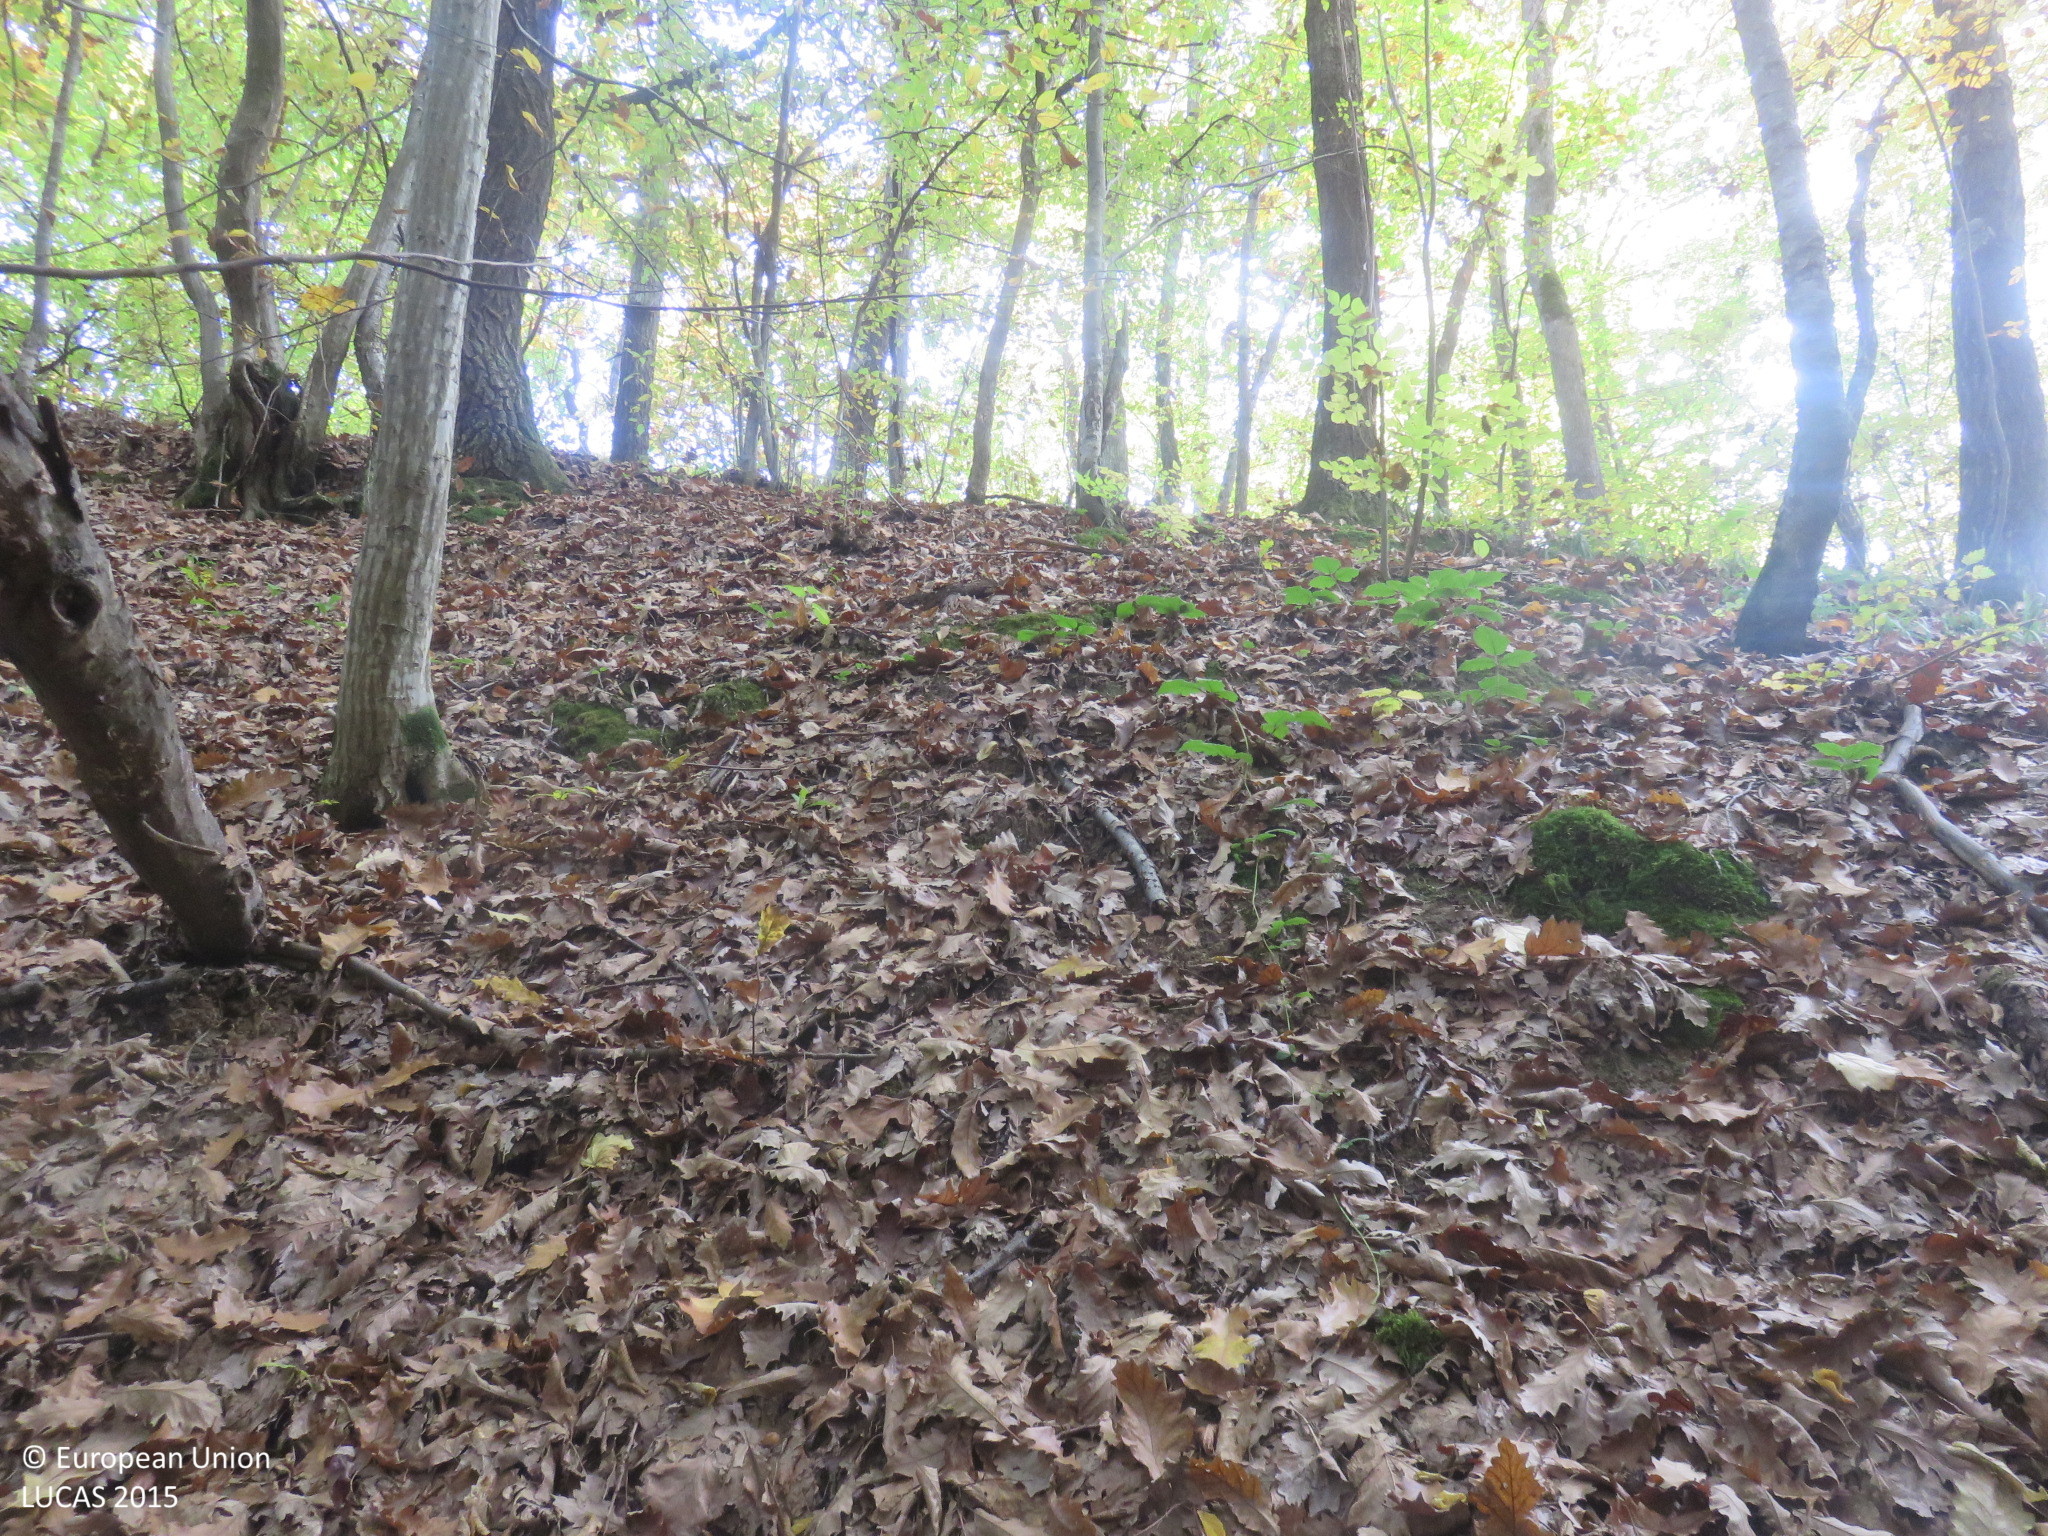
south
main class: Woodland
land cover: Broadleaved woodland
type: beech forest
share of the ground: > 75 %
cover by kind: broadleaved forest trees 90 %, unconsolidated bare surface 10 %
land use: Forestry
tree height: > 5 m
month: October
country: BG
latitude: 42.9763
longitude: 24.7632
